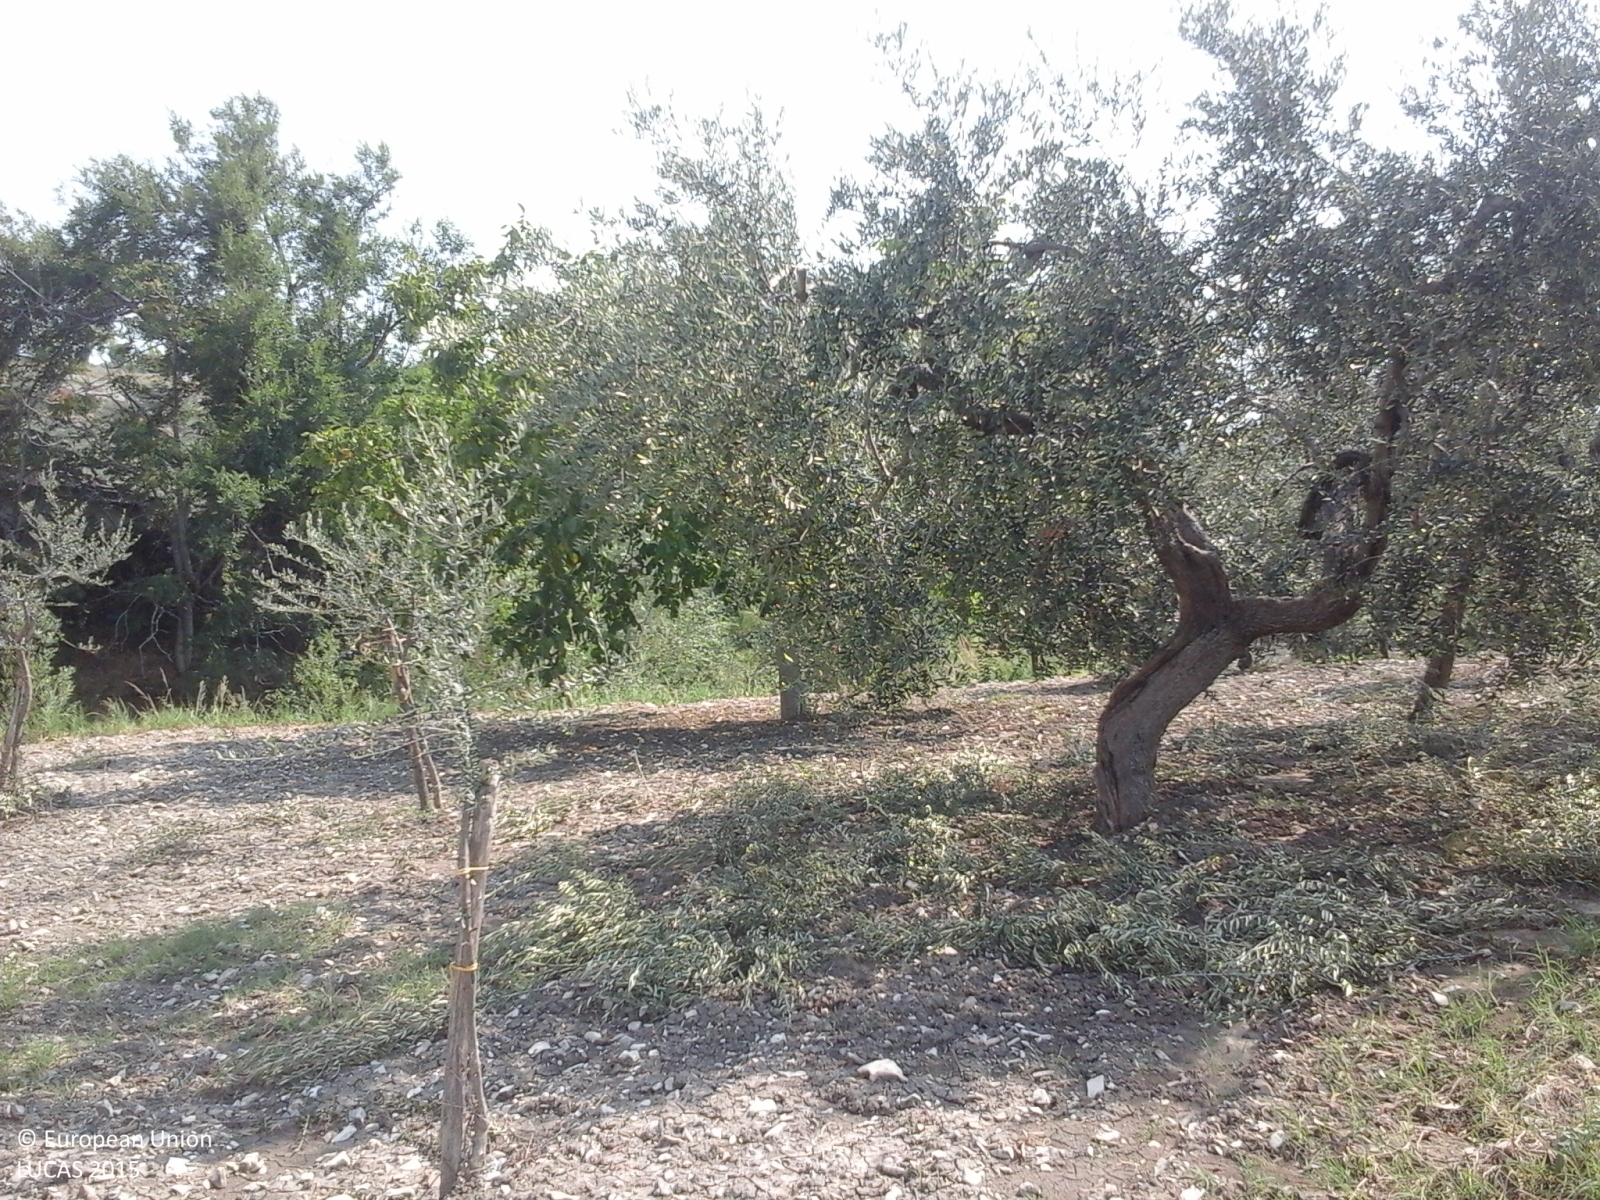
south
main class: Cropland
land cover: Olive groves
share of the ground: 50 - 75 %
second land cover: Spontaneously vegetated surfaces
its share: > 75 %
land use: Agriculture (excluding fallow land and kitchen gardens)
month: August
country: IT
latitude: 41.3988
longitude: 15.1851
